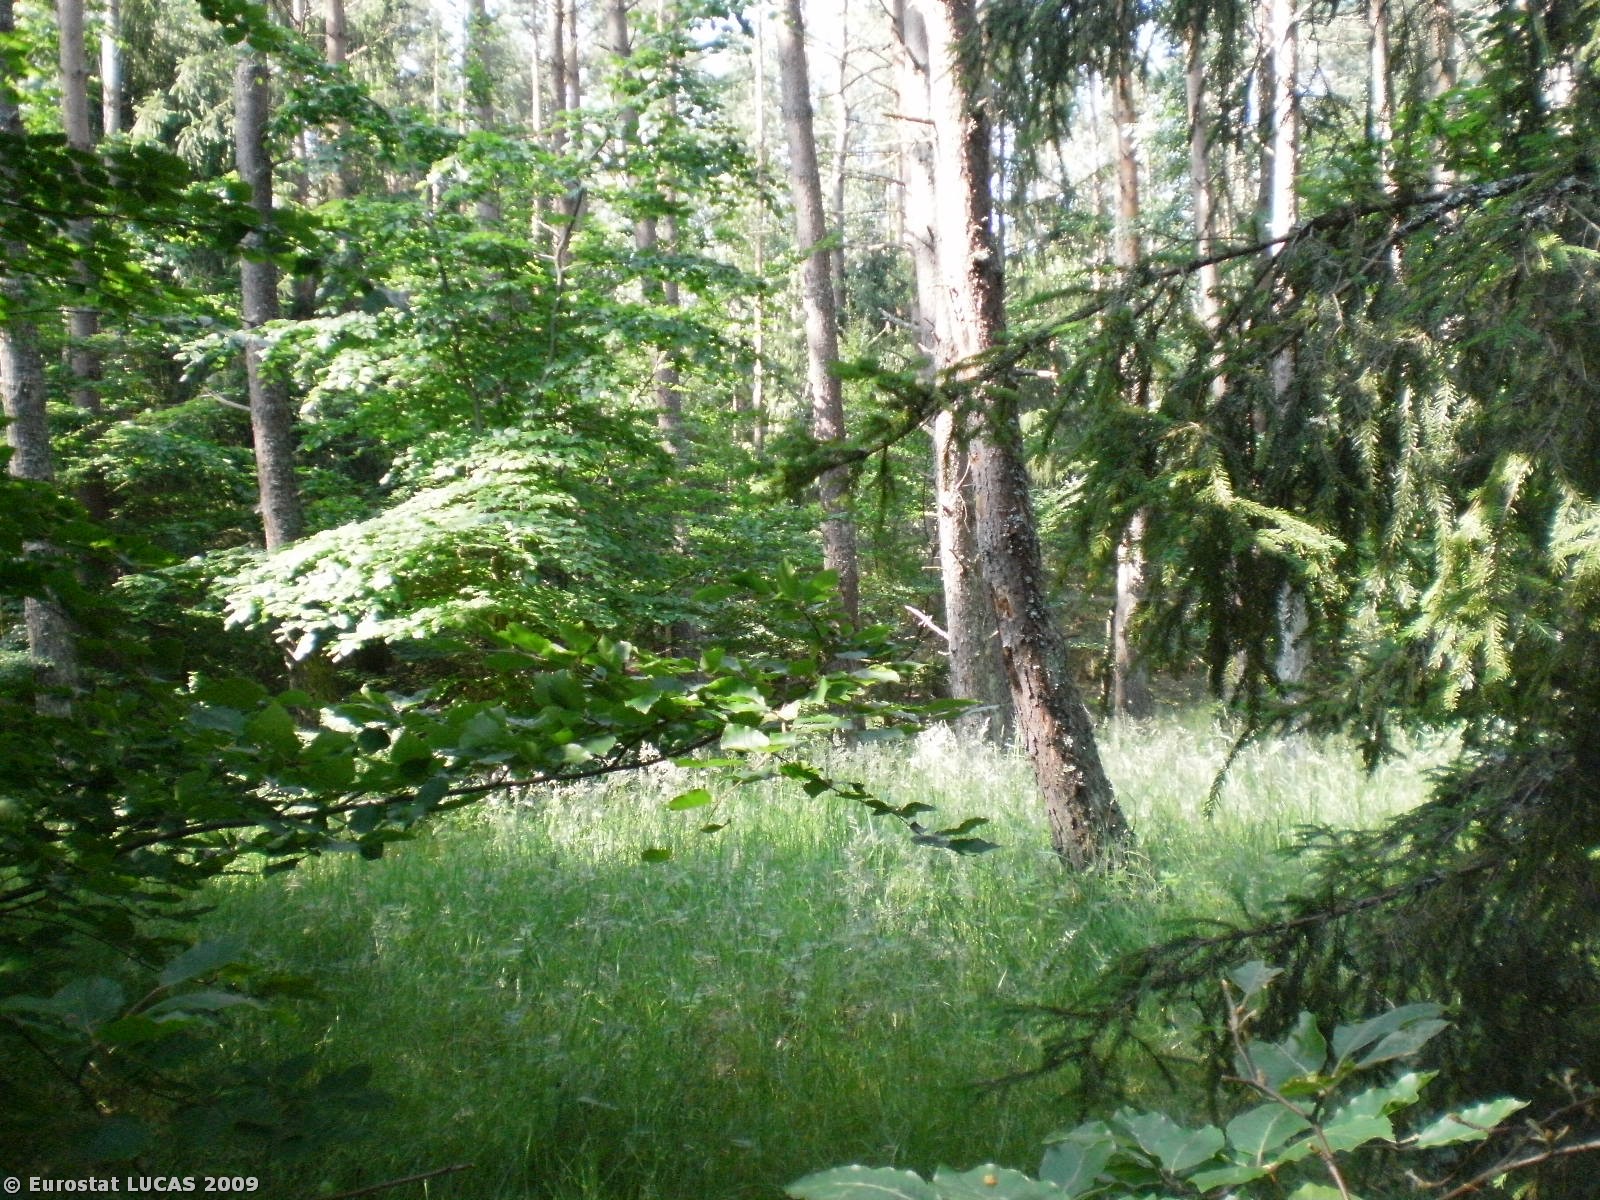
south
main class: Woodland
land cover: Mixed woodland
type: hemiboreal forest and nemoral coniferous forest and mixed broadleaved-coniferous forest
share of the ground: > 75 %
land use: Forestry
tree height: > 5 m
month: July
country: PL
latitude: 54.3020
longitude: 17.2782
